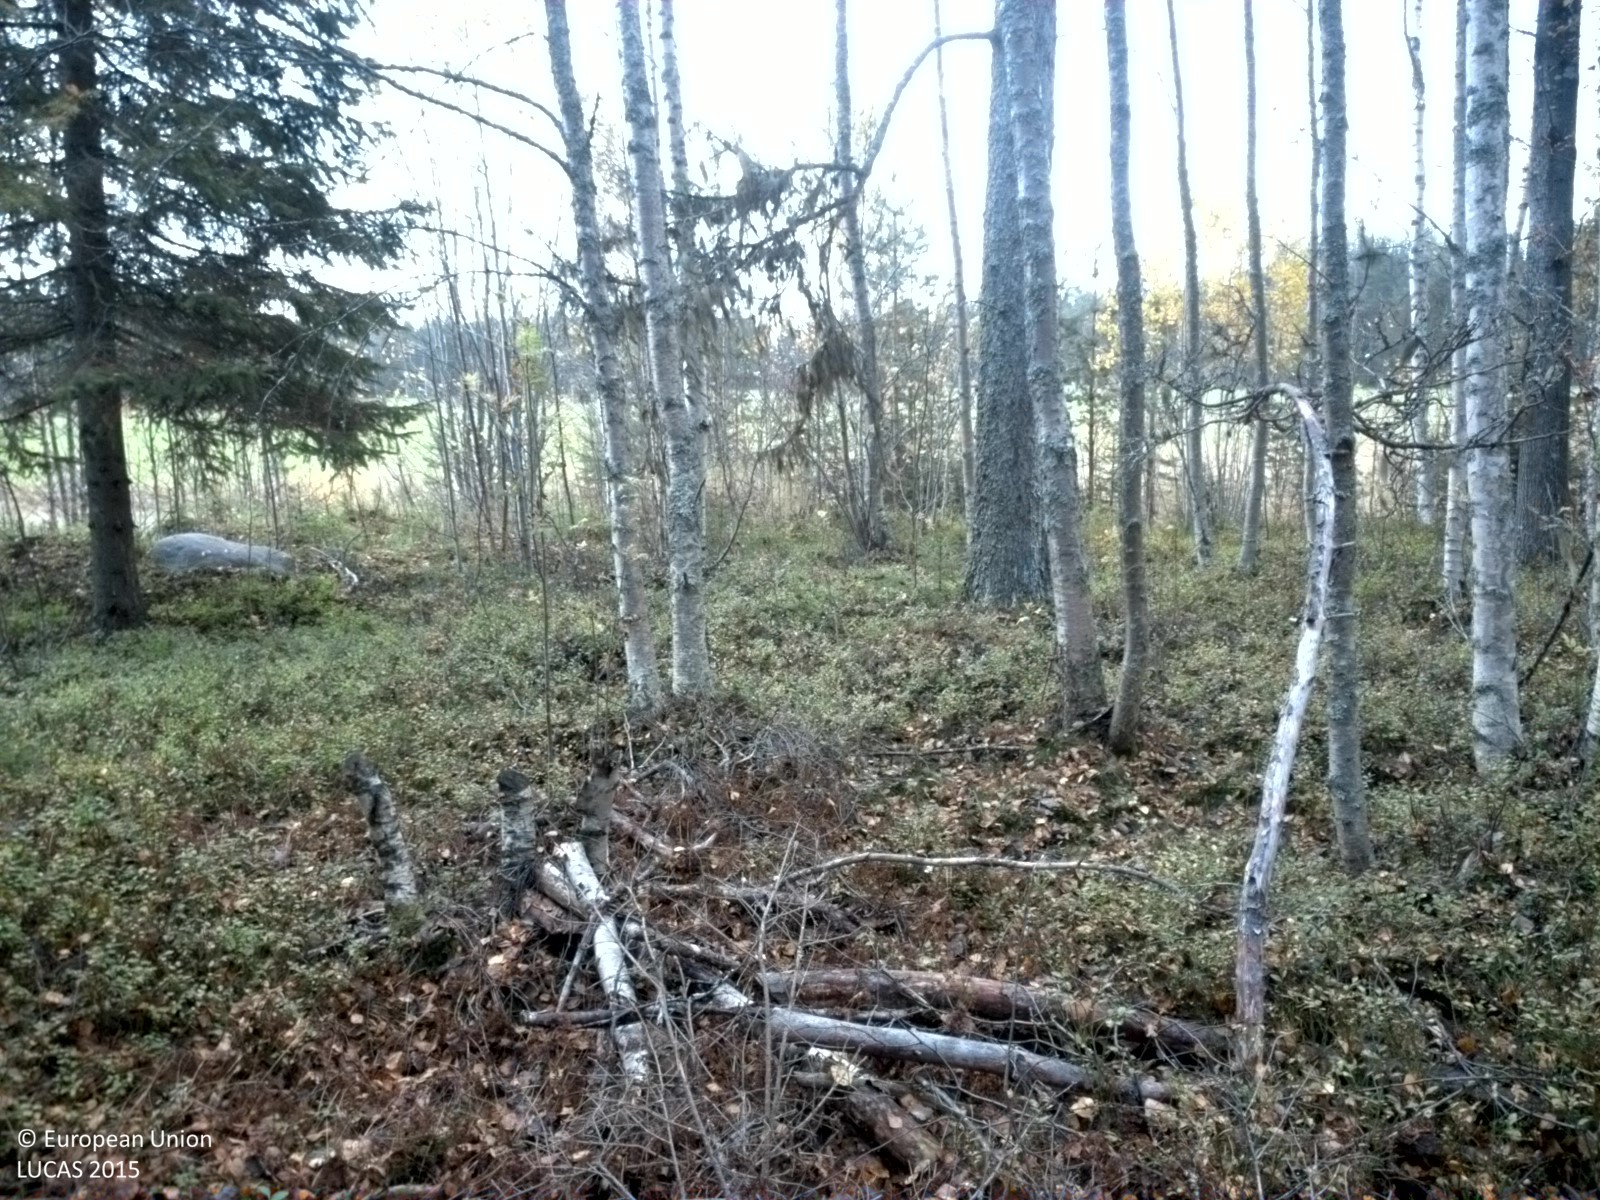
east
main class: Woodland
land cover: Spruce dominated mixed woodland
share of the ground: 25 - 50 %
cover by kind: shrubs 50 %, broadleaved forest trees 30 %, coniferous forest trees 20 %
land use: Forestry
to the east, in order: Spruce dominated mixed woodland; Grassland without tree/shrub cover; Ditches and canals; Grassland without tree/shrub cover; Grassland with sparse tree/shrub cover; Rivers and streams; Broadleaved woodland; Grassland with sparse tree/shrub cover; Single bushes/trees; Grassland without tree/shrub cover
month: October
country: SE
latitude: 65.6340
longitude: 21.9022
